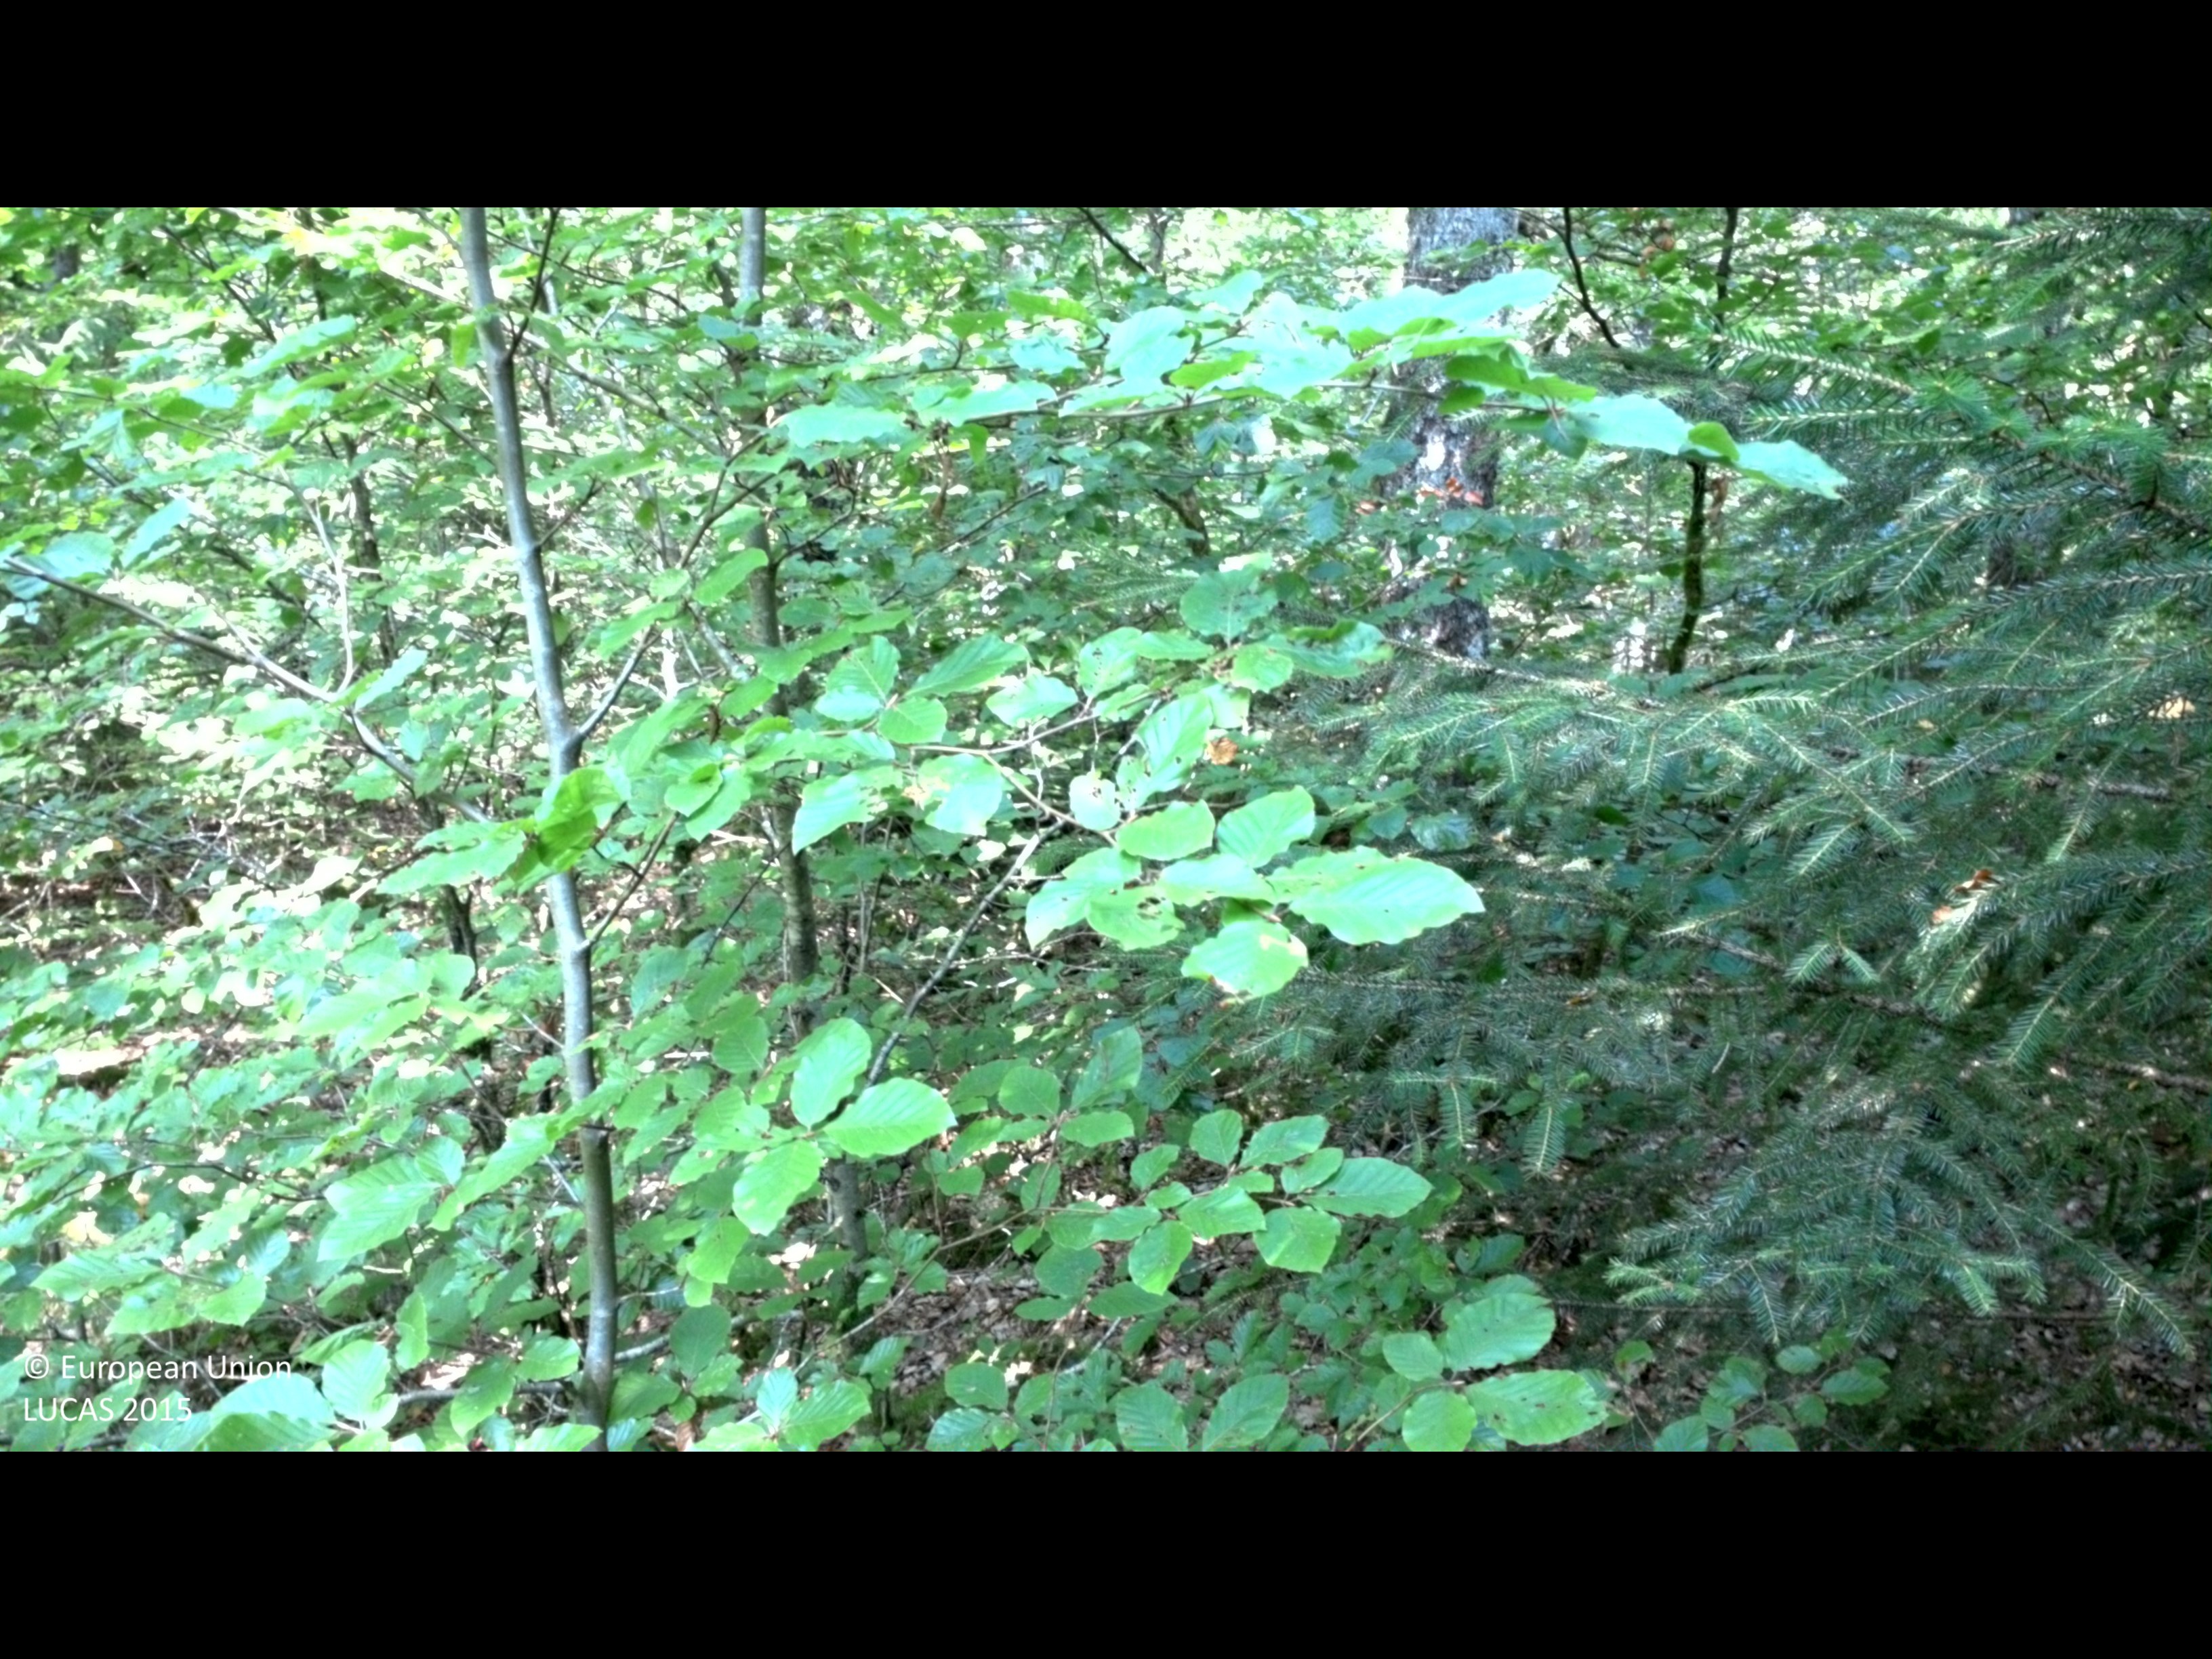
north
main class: Woodland
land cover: Broadleaved woodland
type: hemiboreal forest and nemoral coniferous forest and mixed broadleaved-coniferous forest
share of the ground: > 75 %
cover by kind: broadleaved forest trees 85 %, shrubs 10 %, coniferous forest trees 5 %
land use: Forestry
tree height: > 5 m
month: August
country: SE
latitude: 56.8849
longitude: 13.2297
